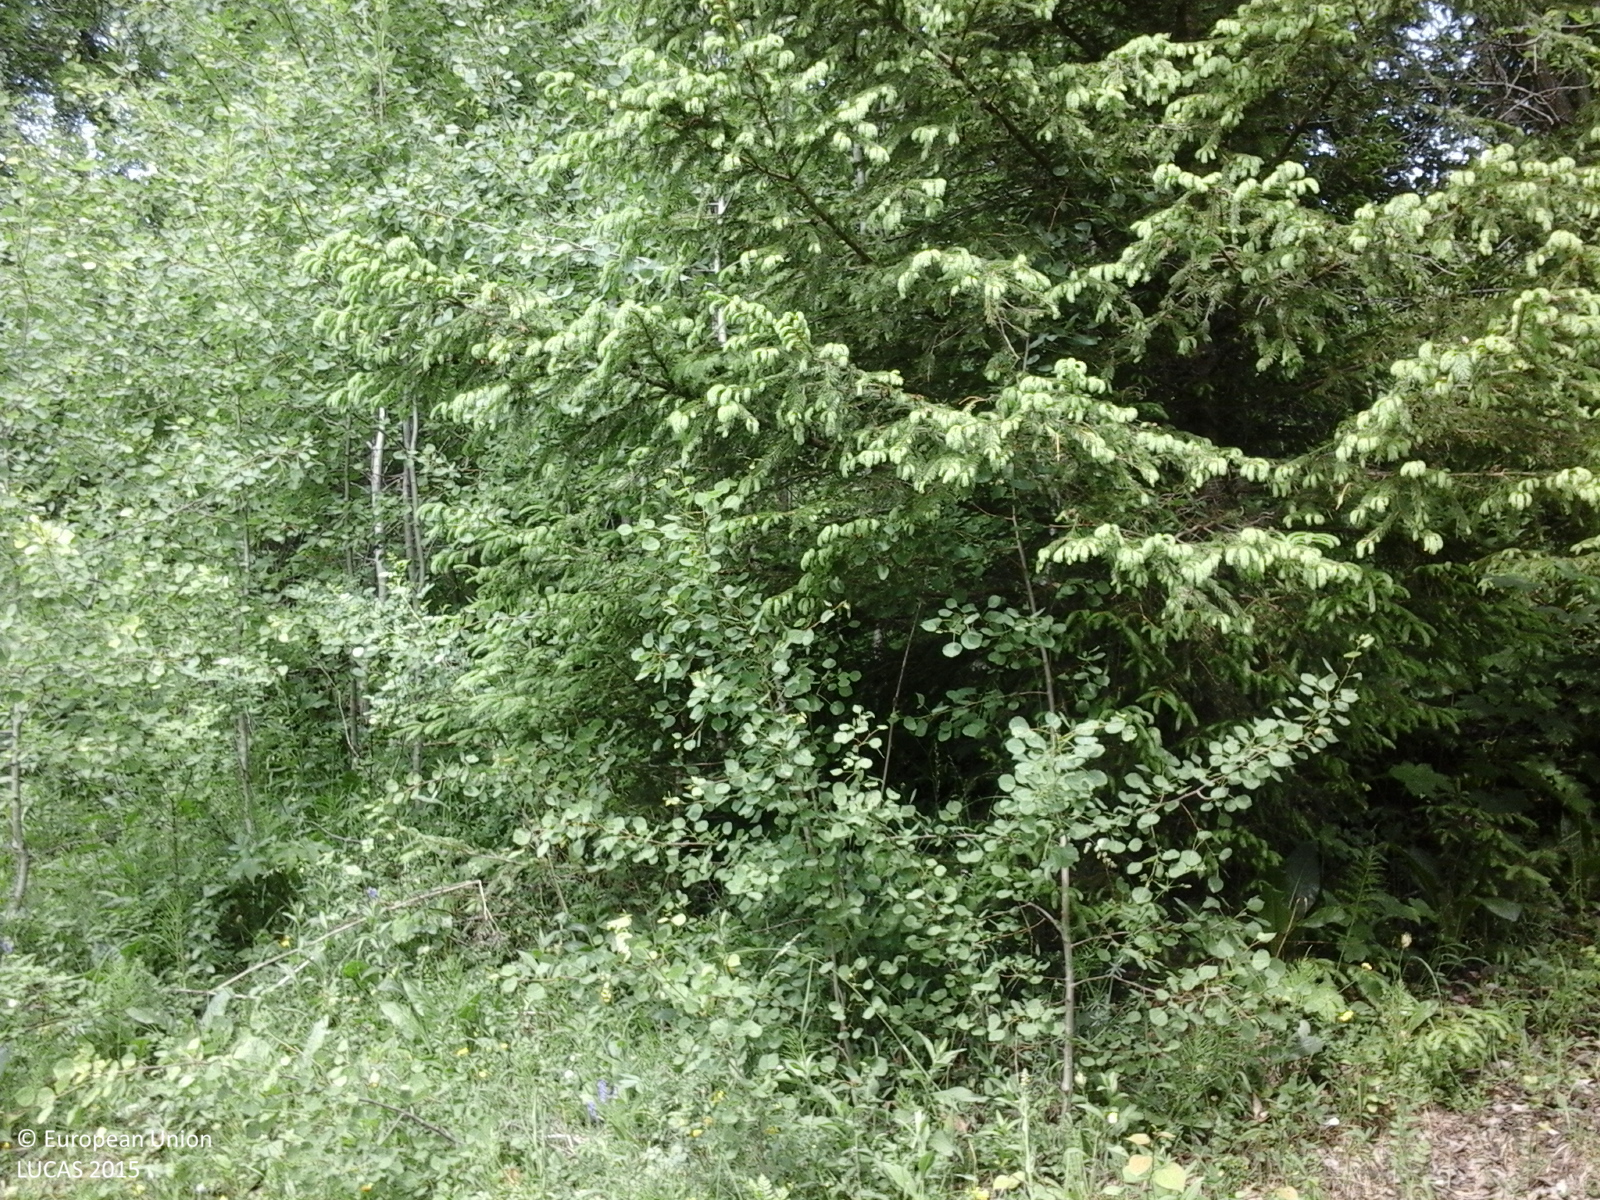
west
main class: Woodland
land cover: Broadleaved woodland
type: mountainous beech forest
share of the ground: > 75 %
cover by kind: broadleaved forest trees 80 %, coniferous forest trees 20 %
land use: Forestry
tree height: > 5 m
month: June
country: RO
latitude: 46.7900
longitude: 25.9871
